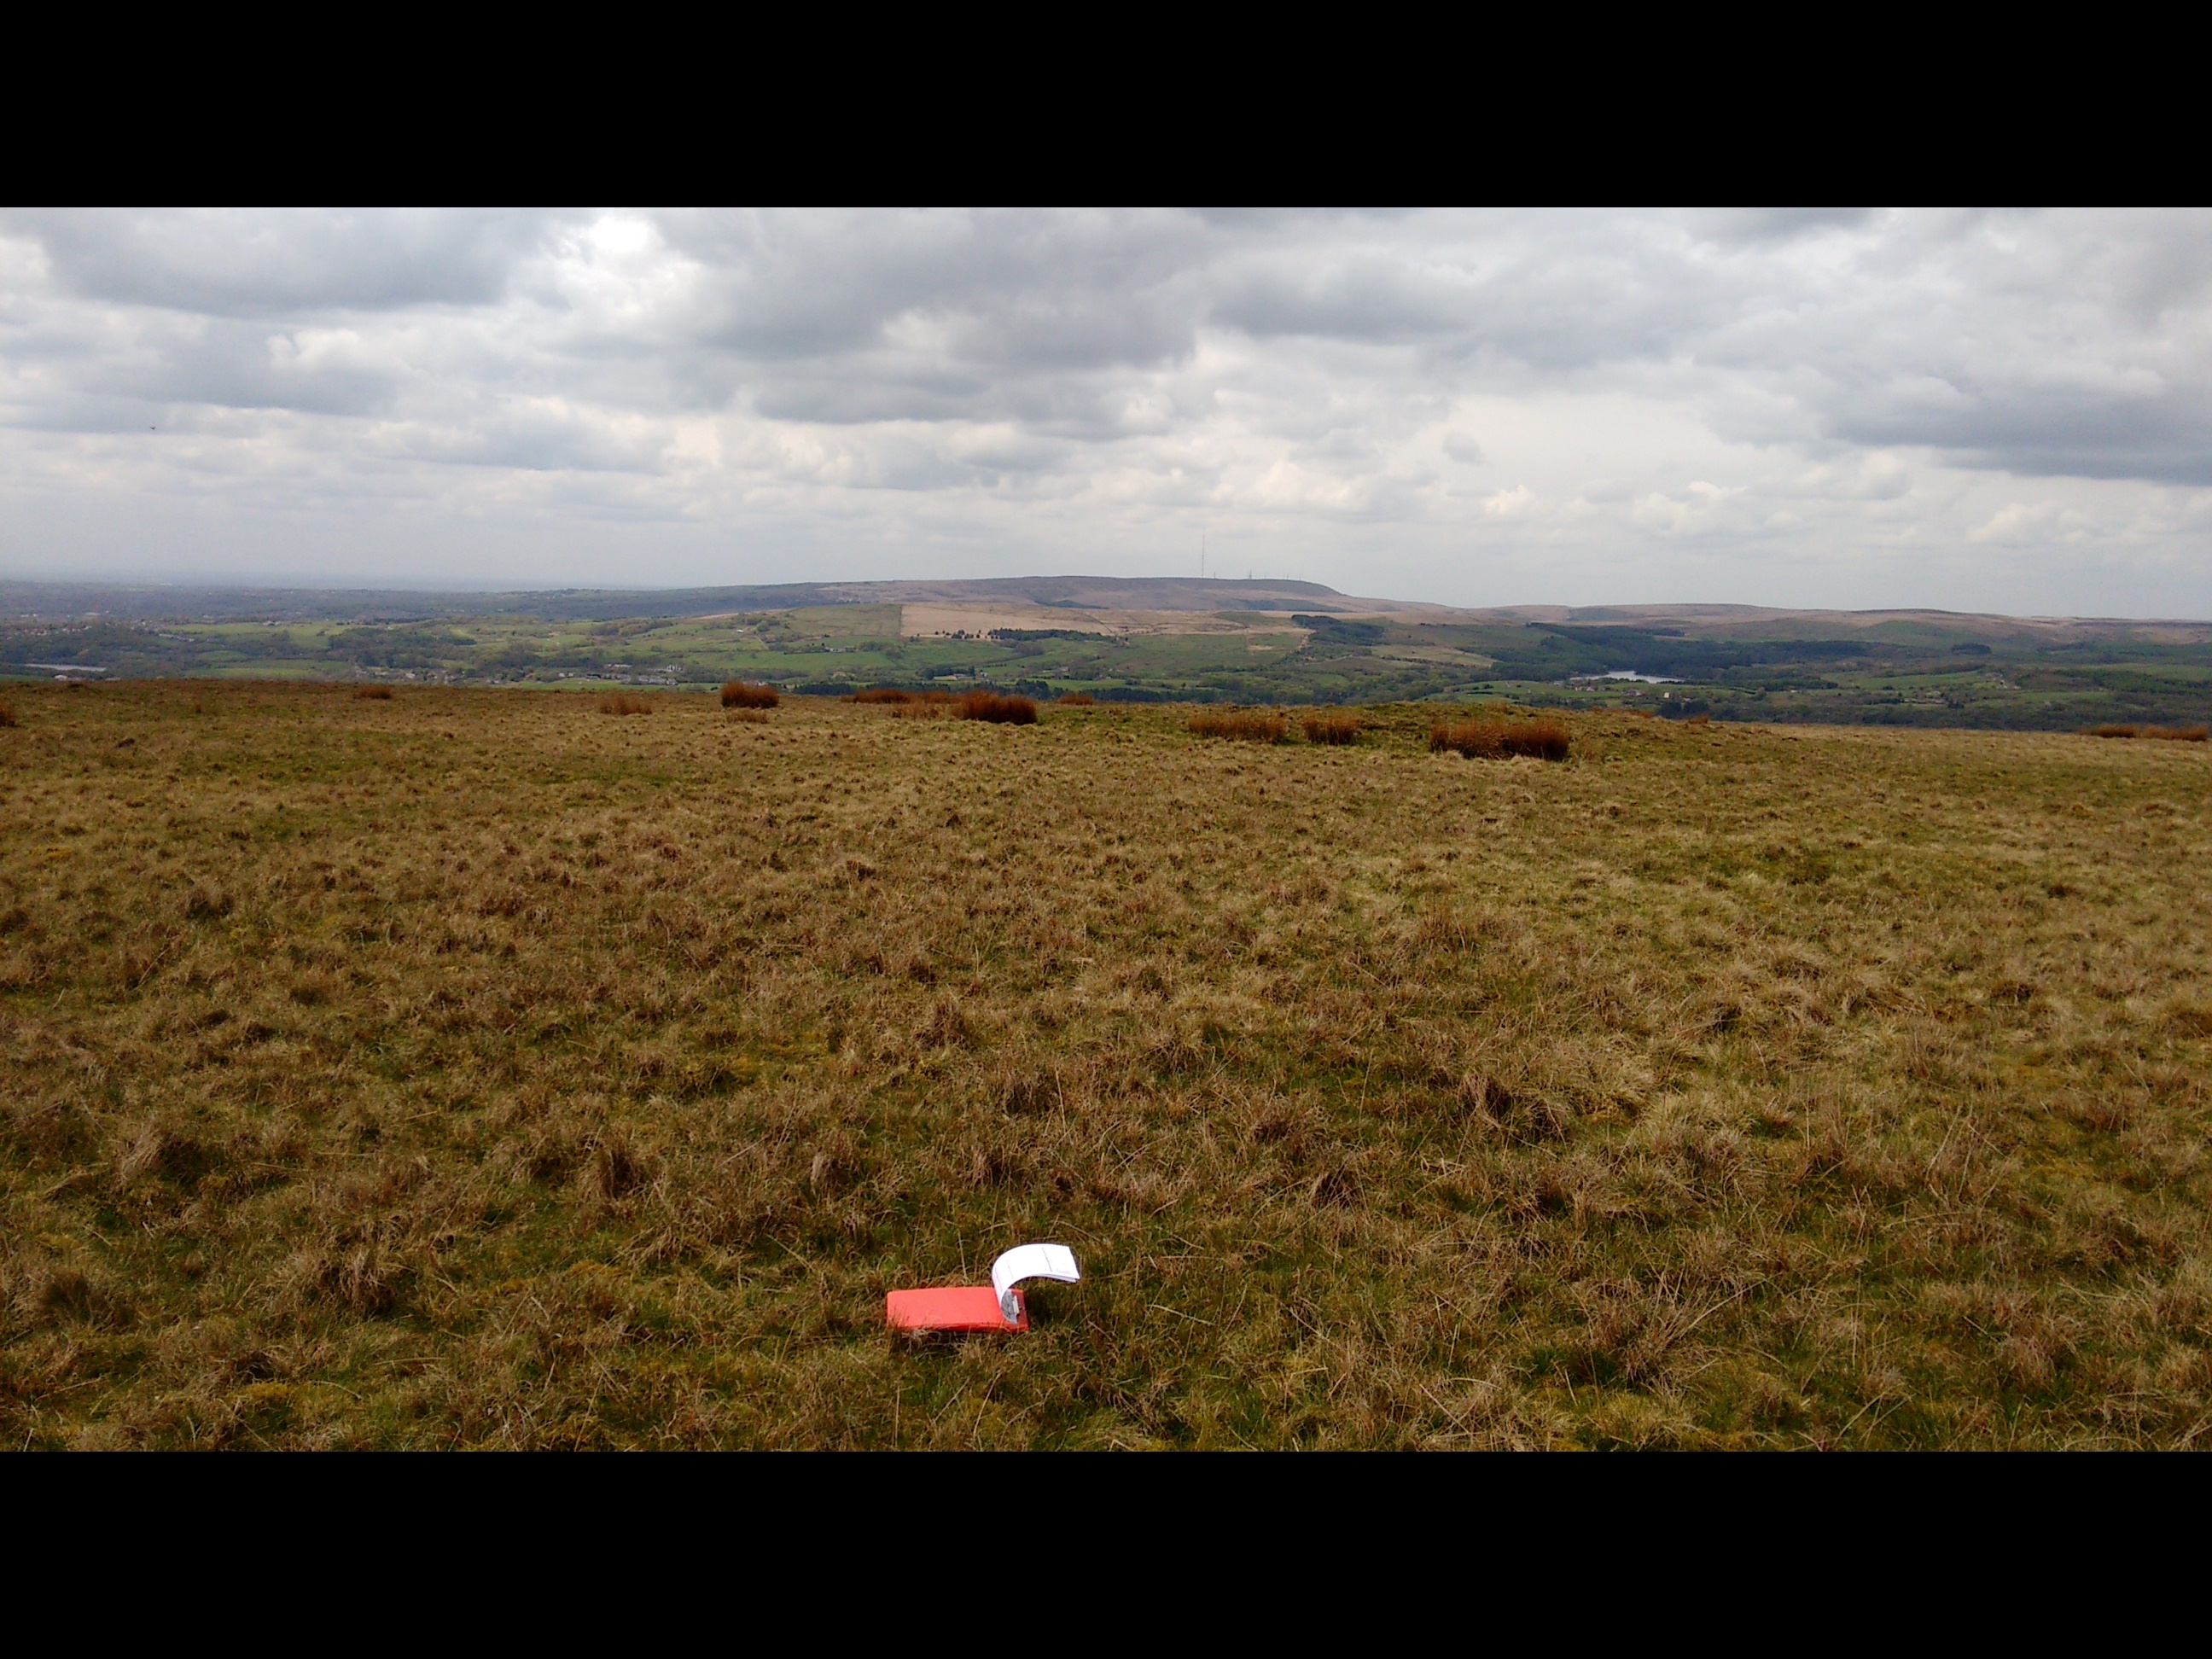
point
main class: Grassland
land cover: Grassland without tree/shrub cover
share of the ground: > 75 %
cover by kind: herbaceous plants 100 %
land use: Agriculture (excluding fallow land and kitchen gardens)
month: May
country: GB
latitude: 53.6570
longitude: -2.3649
